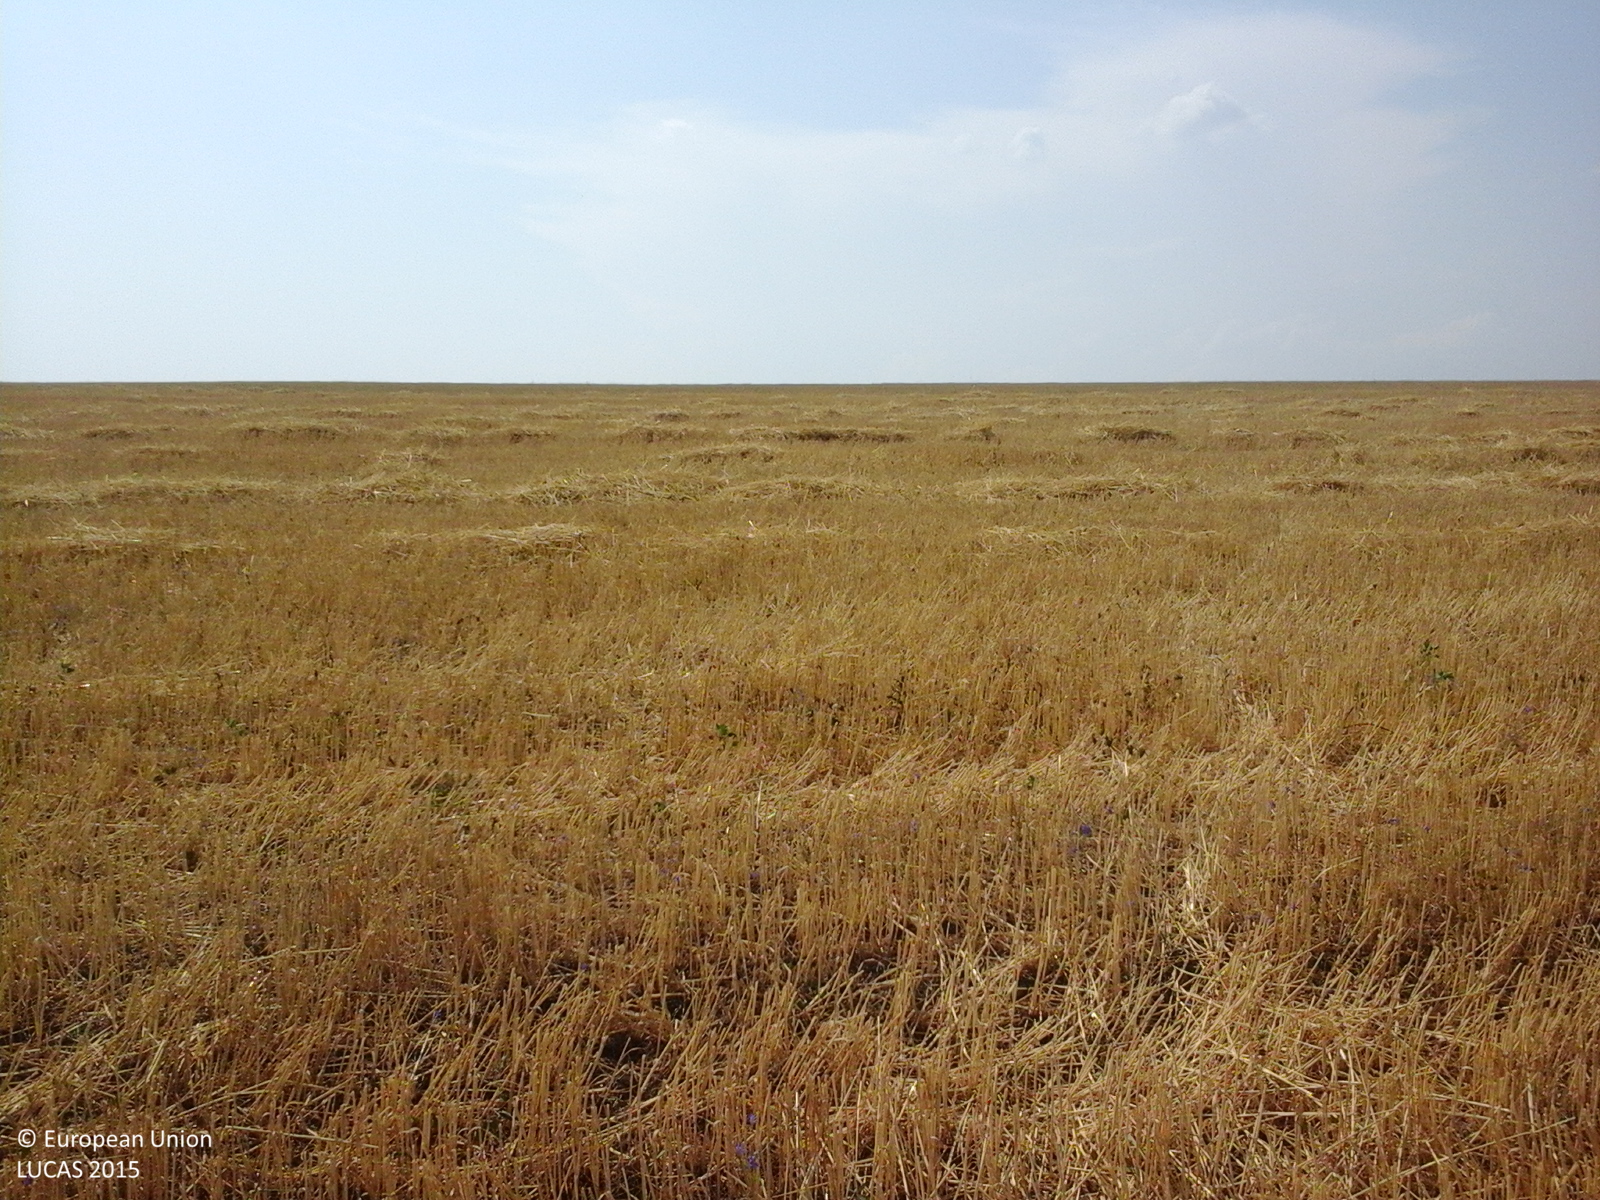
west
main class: Cropland
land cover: Common wheat
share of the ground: > 75 %
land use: Agriculture (excluding fallow land and kitchen gardens)
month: July
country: RO
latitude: 45.7610
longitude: 27.9249
